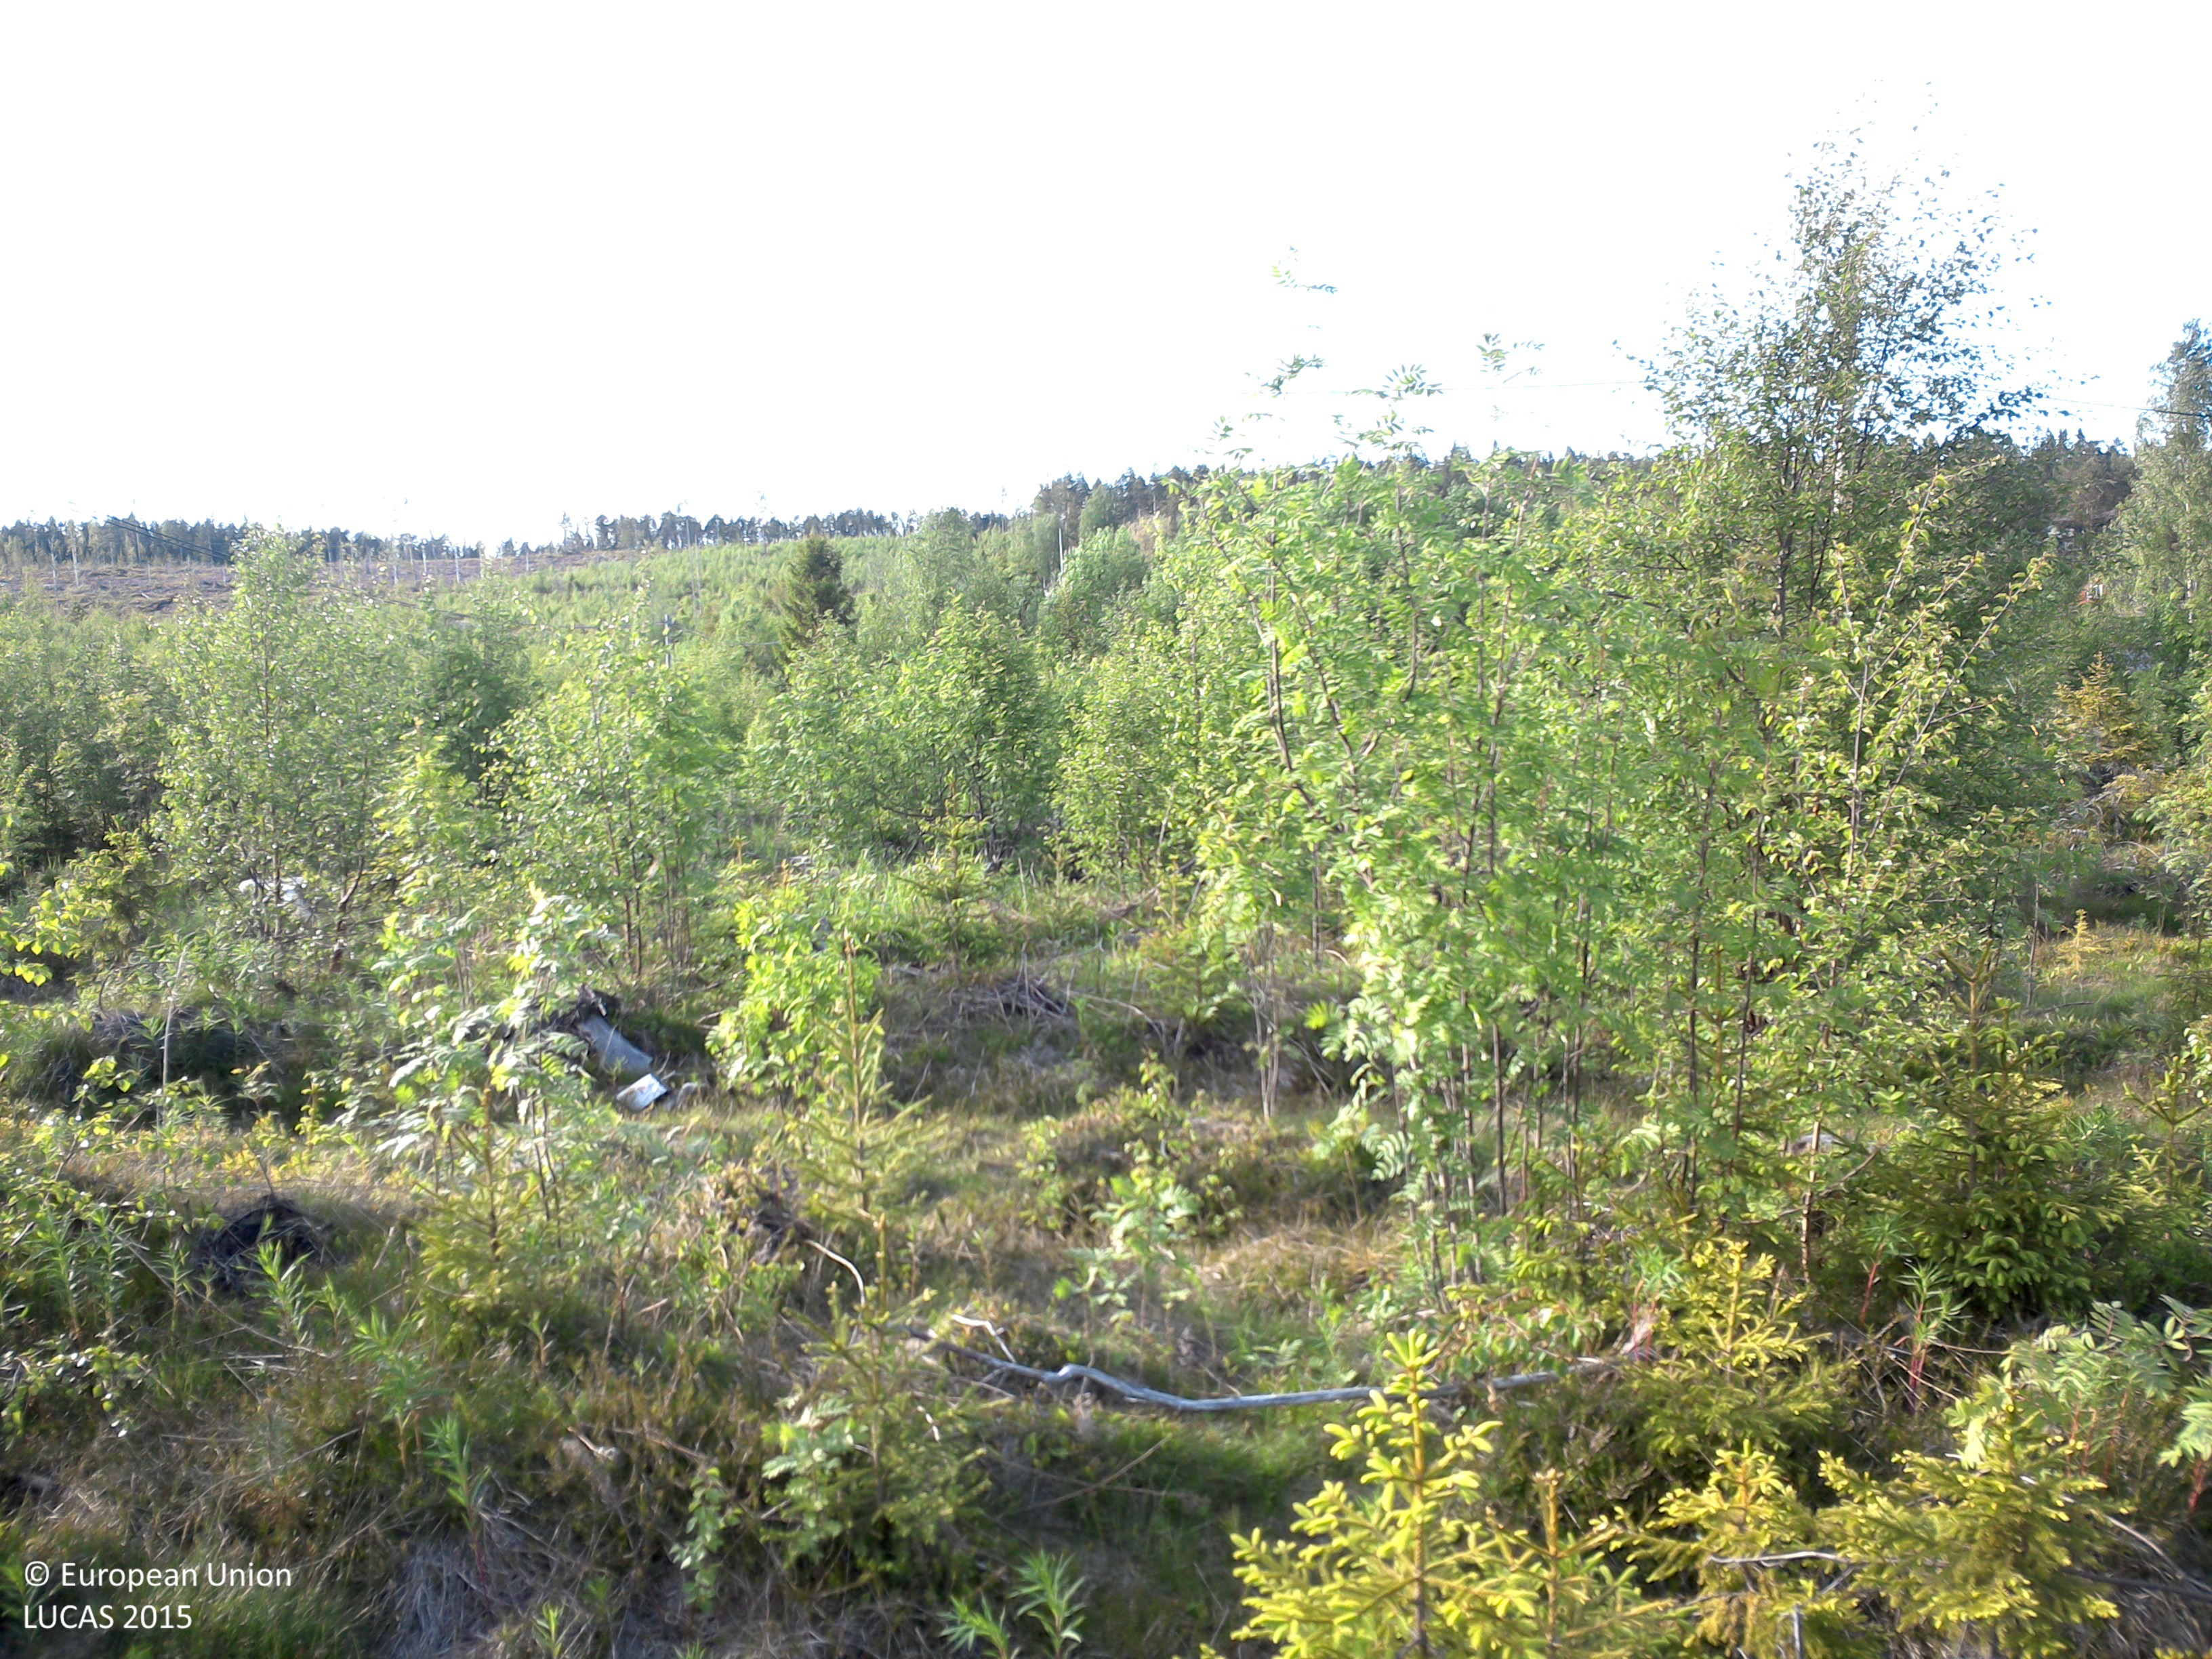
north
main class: Woodland
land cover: Broadleaved woodland
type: boreal forest
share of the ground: 10 - 25 %
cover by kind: herbaceous plants 85 %, broadleaved forest trees 15 %
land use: Forestry
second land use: Sport
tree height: < 5 m
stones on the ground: < 10 %
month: June
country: SE
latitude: 62.6416
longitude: 17.8797
